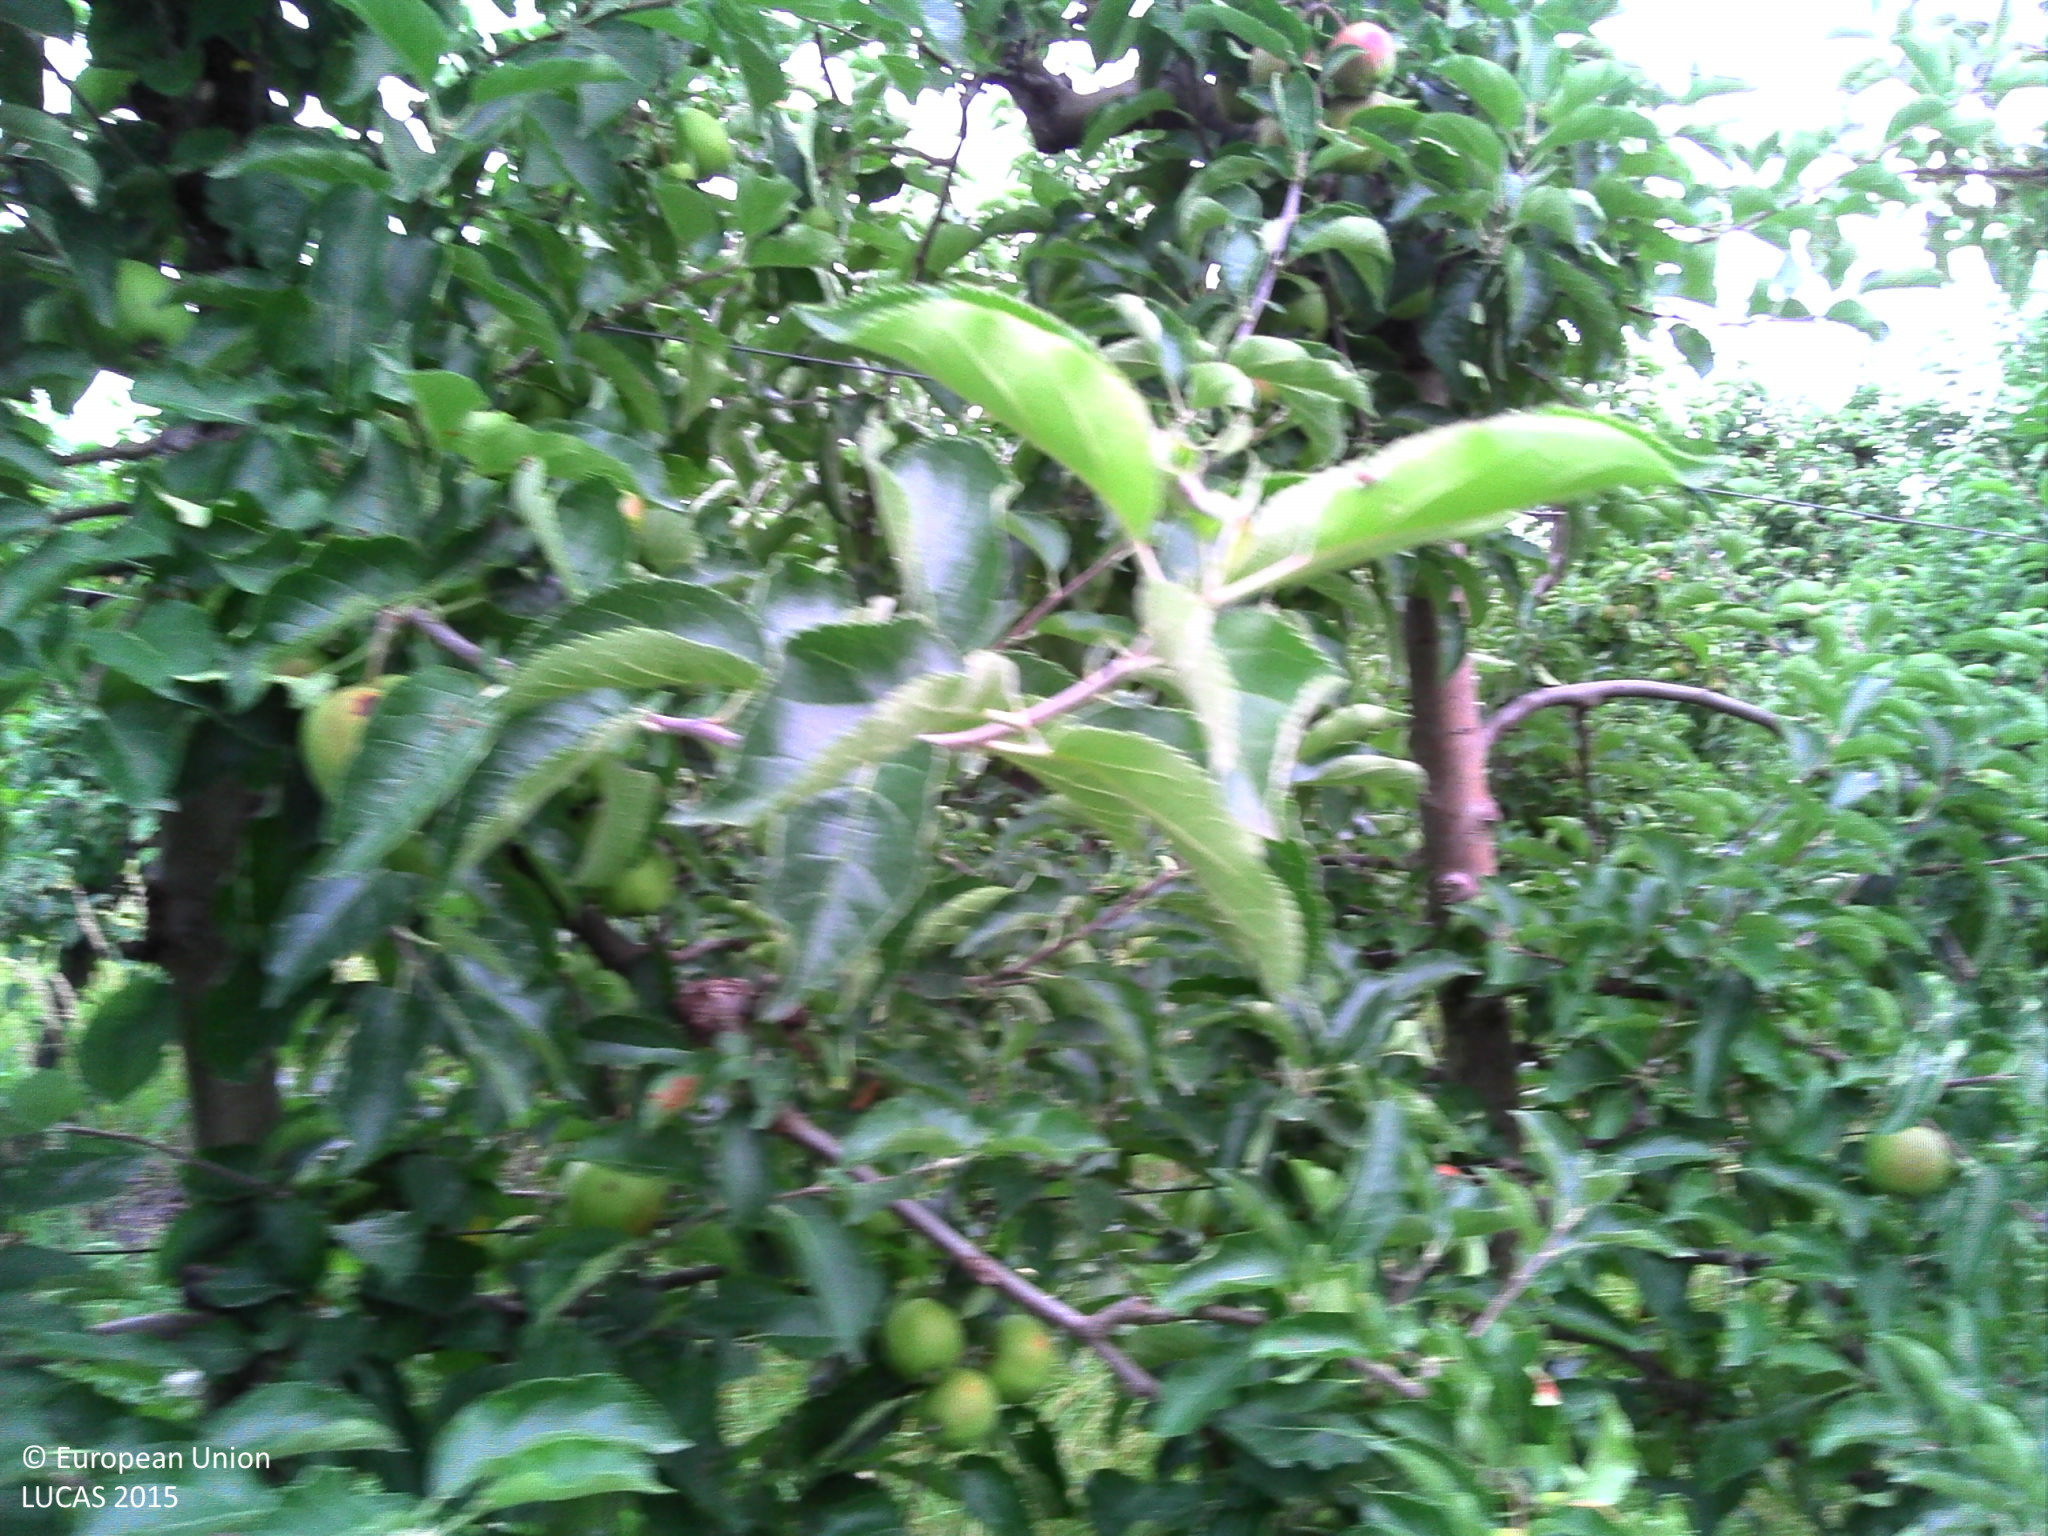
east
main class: Cropland
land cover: Apple fruit
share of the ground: 50 - 75 %
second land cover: Grassland without tree/shrub cover
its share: 25 - 50 %
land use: Agriculture (excluding fallow land and kitchen gardens)
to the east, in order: Apple fruit; Grassland without tree/shrub cover; Tracks; Apple fruit; Tracks; Common wheat
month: July
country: BE
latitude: 50.9048
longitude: 5.0342
